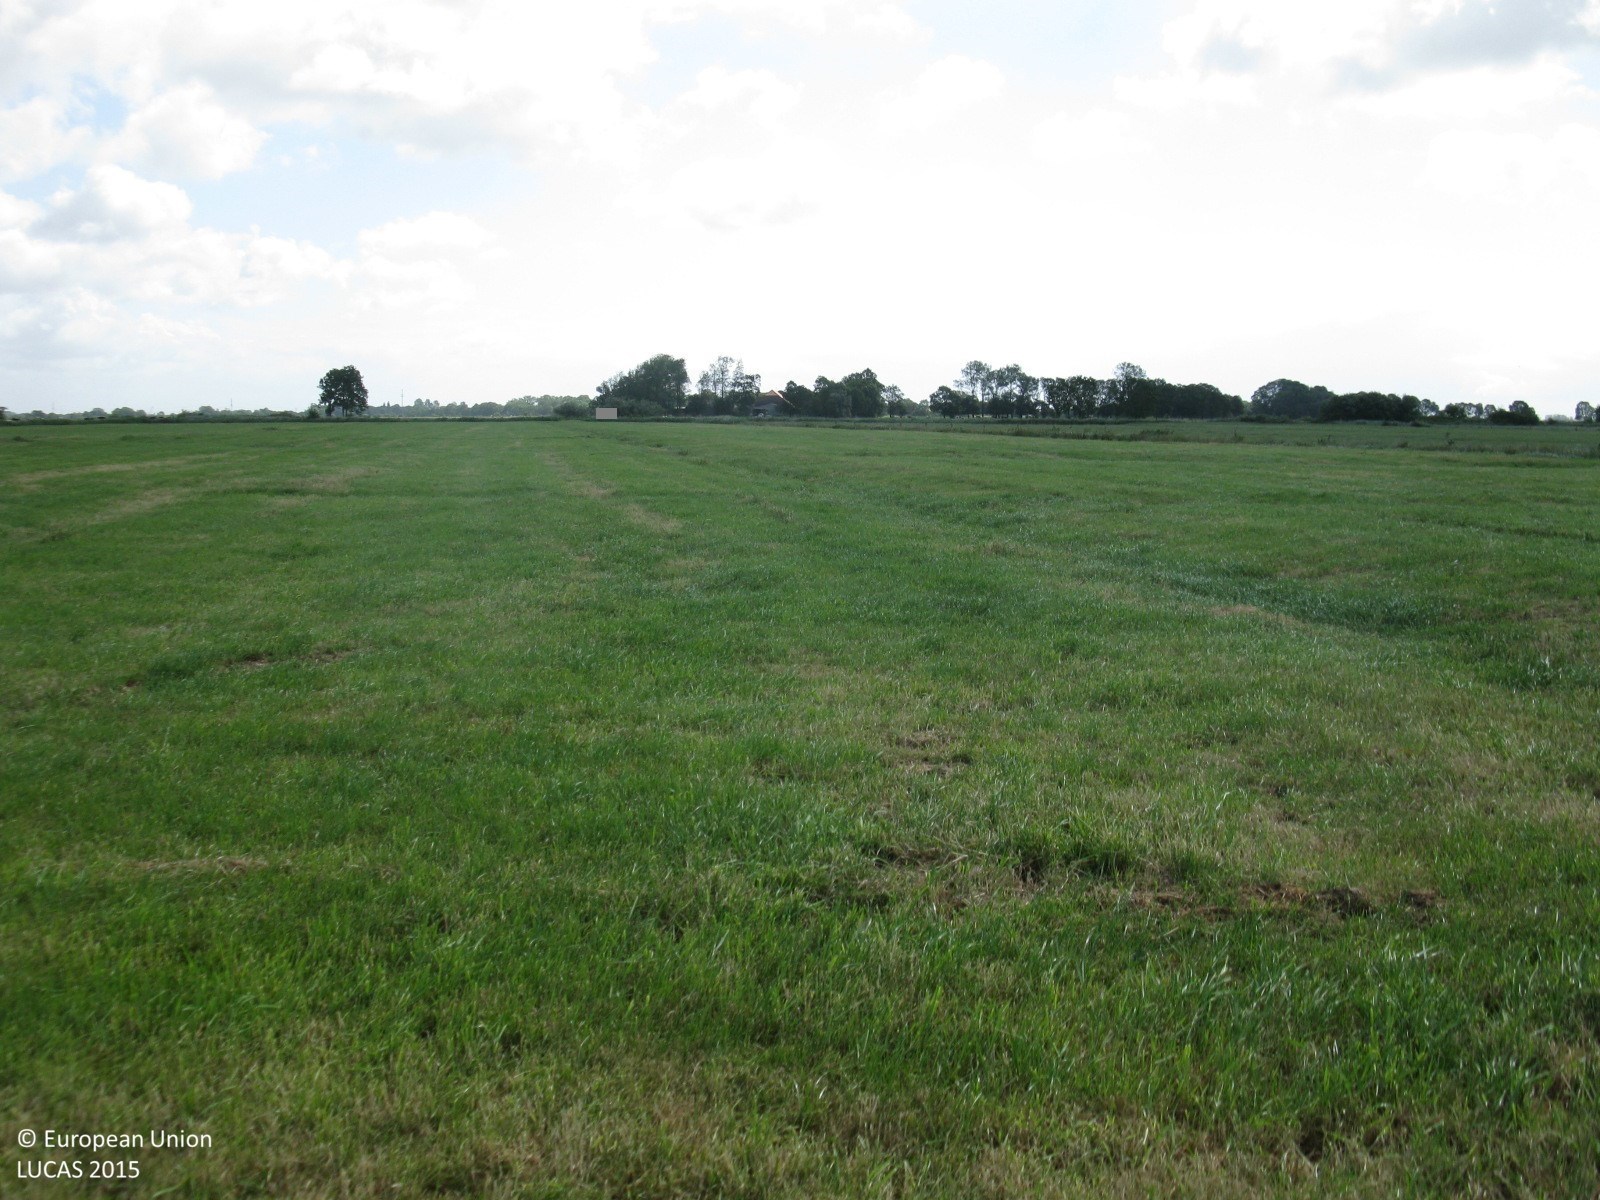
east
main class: Grassland
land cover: Grassland without tree/shrub cover
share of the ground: > 75 %
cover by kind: herbaceous plants 100 %
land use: Agriculture (excluding fallow land and kitchen gardens)
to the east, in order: Grassland without tree/shrub cover; Fences; Ditches and canals; Fences; Grassland without tree/shrub cover; Fences; Ditches and canals; Fences; Grassland without tree/shrub cover
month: July
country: DE
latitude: 53.4743
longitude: 7.9366
